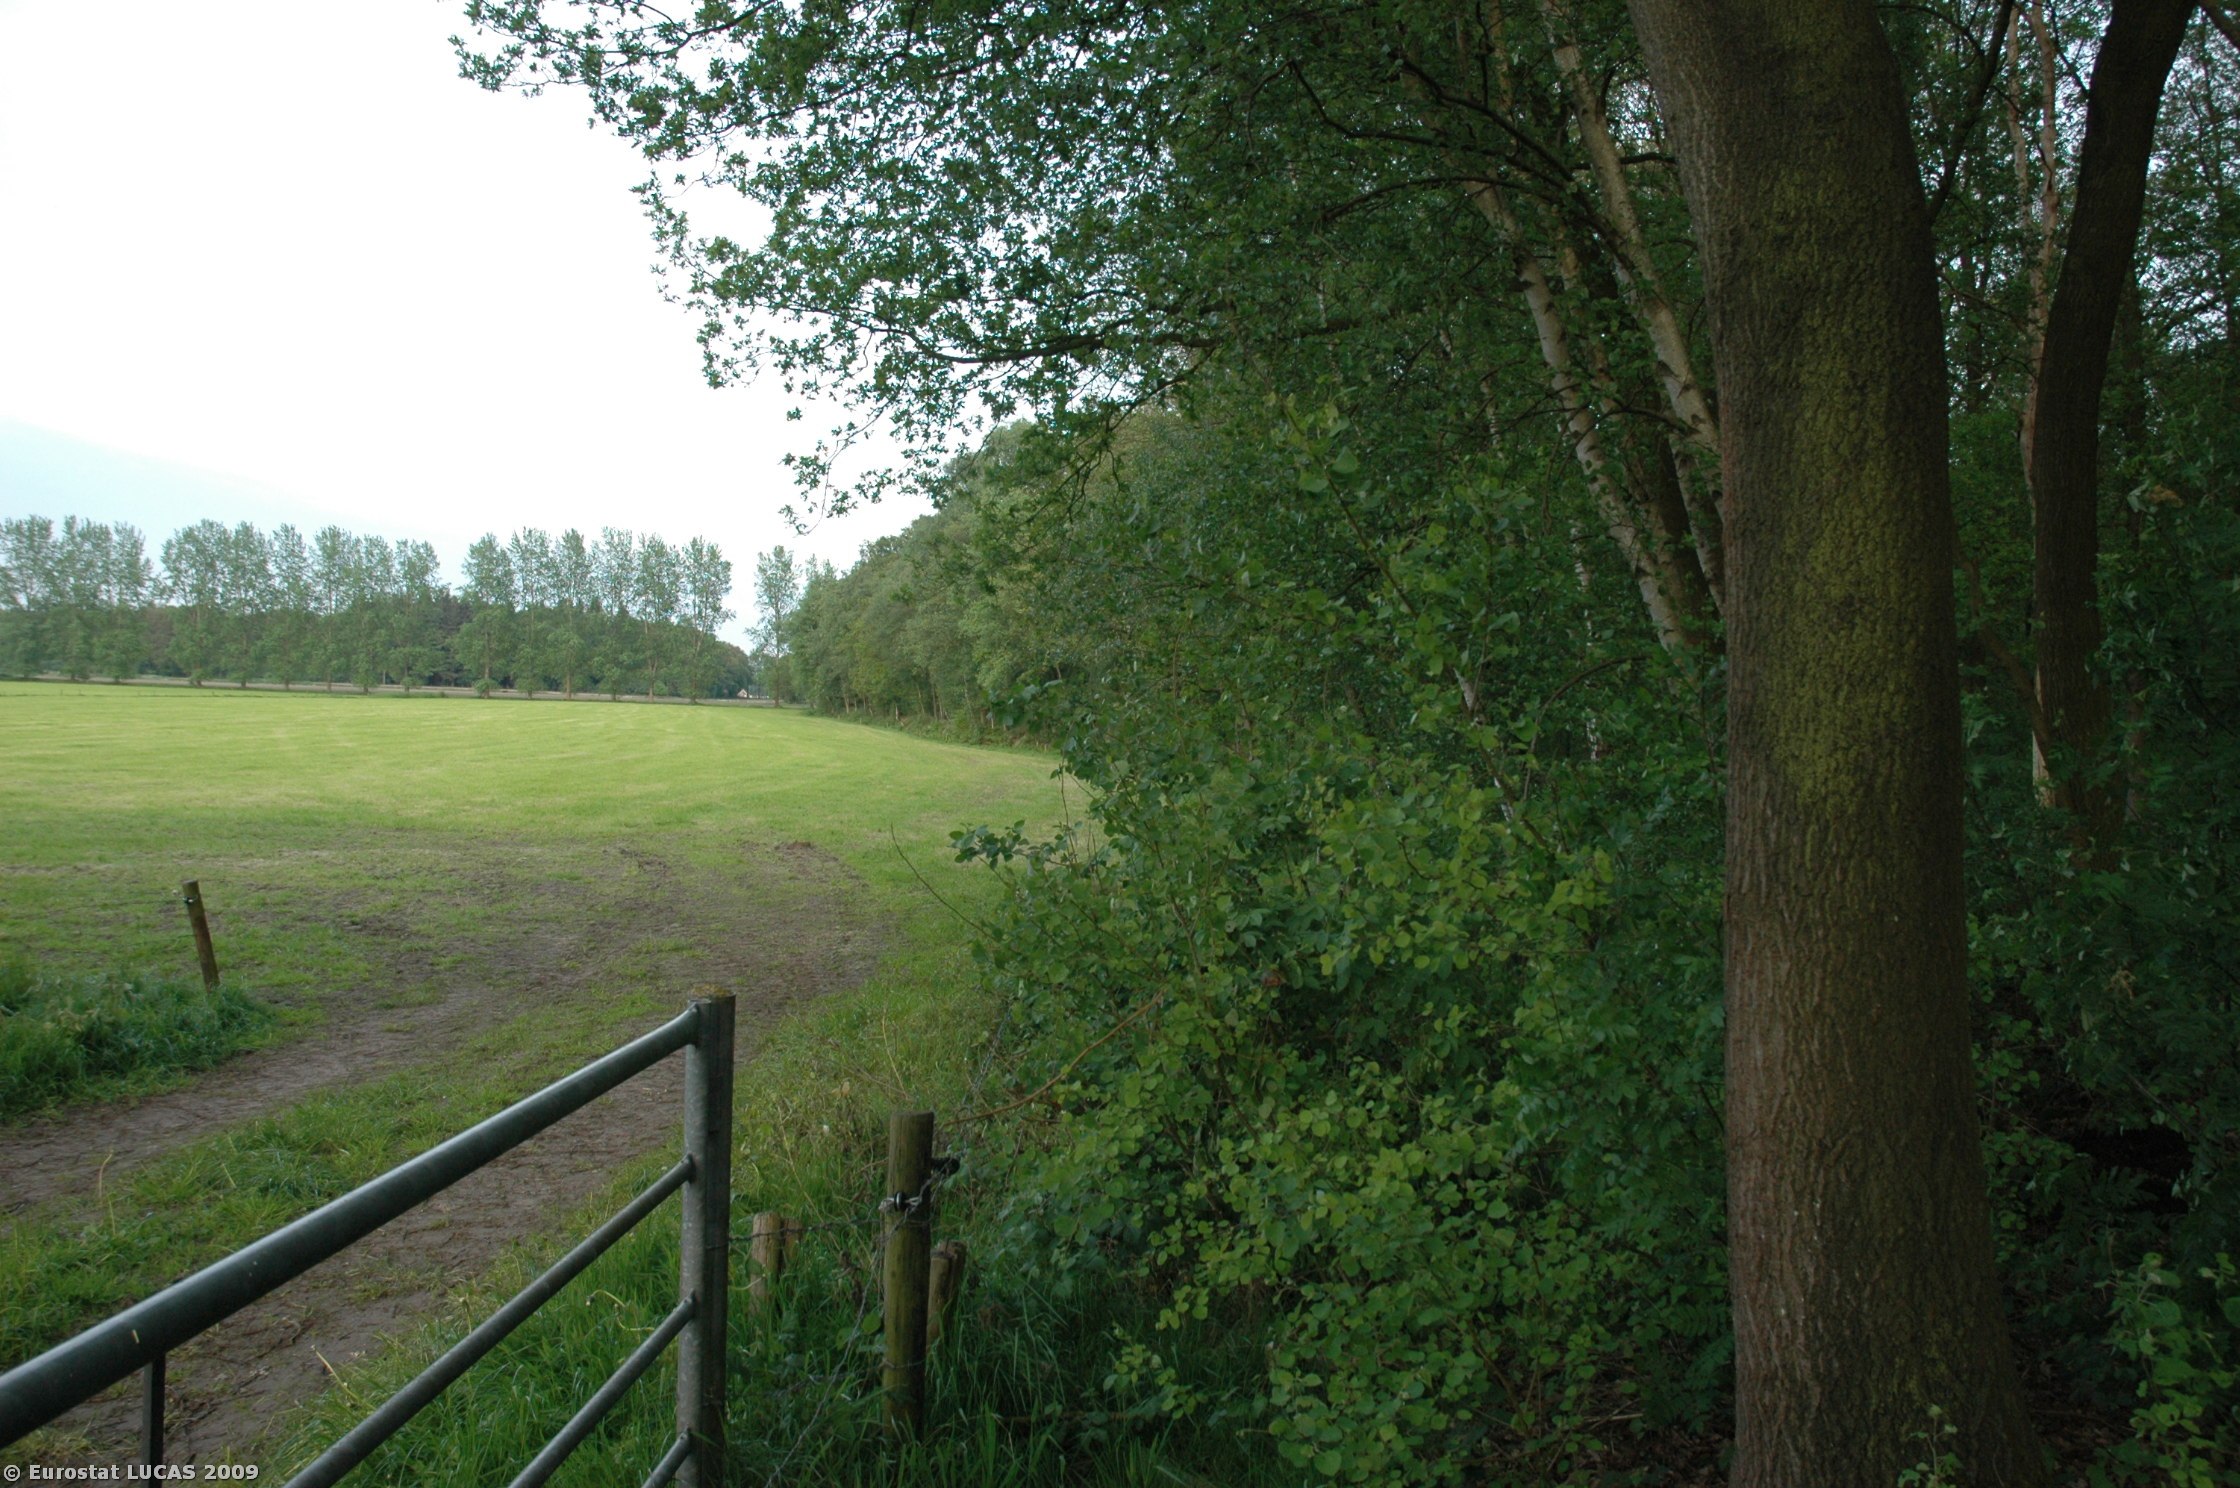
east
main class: Grassland
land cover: Grassland without tree/shrub cover
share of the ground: > 75 %
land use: Agriculture (excluding fallow land and kitchen gardens)
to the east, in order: Grassland without tree/shrub cover; Fences; Ditches and canals; Broadleaved woodland; Tracks; Broadleaved woodland; Ditches and canals; Fences; Grassland without tree/shrub cover; Fences; Ditches and canals
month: May
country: NL
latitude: 52.0556
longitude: 5.4334
